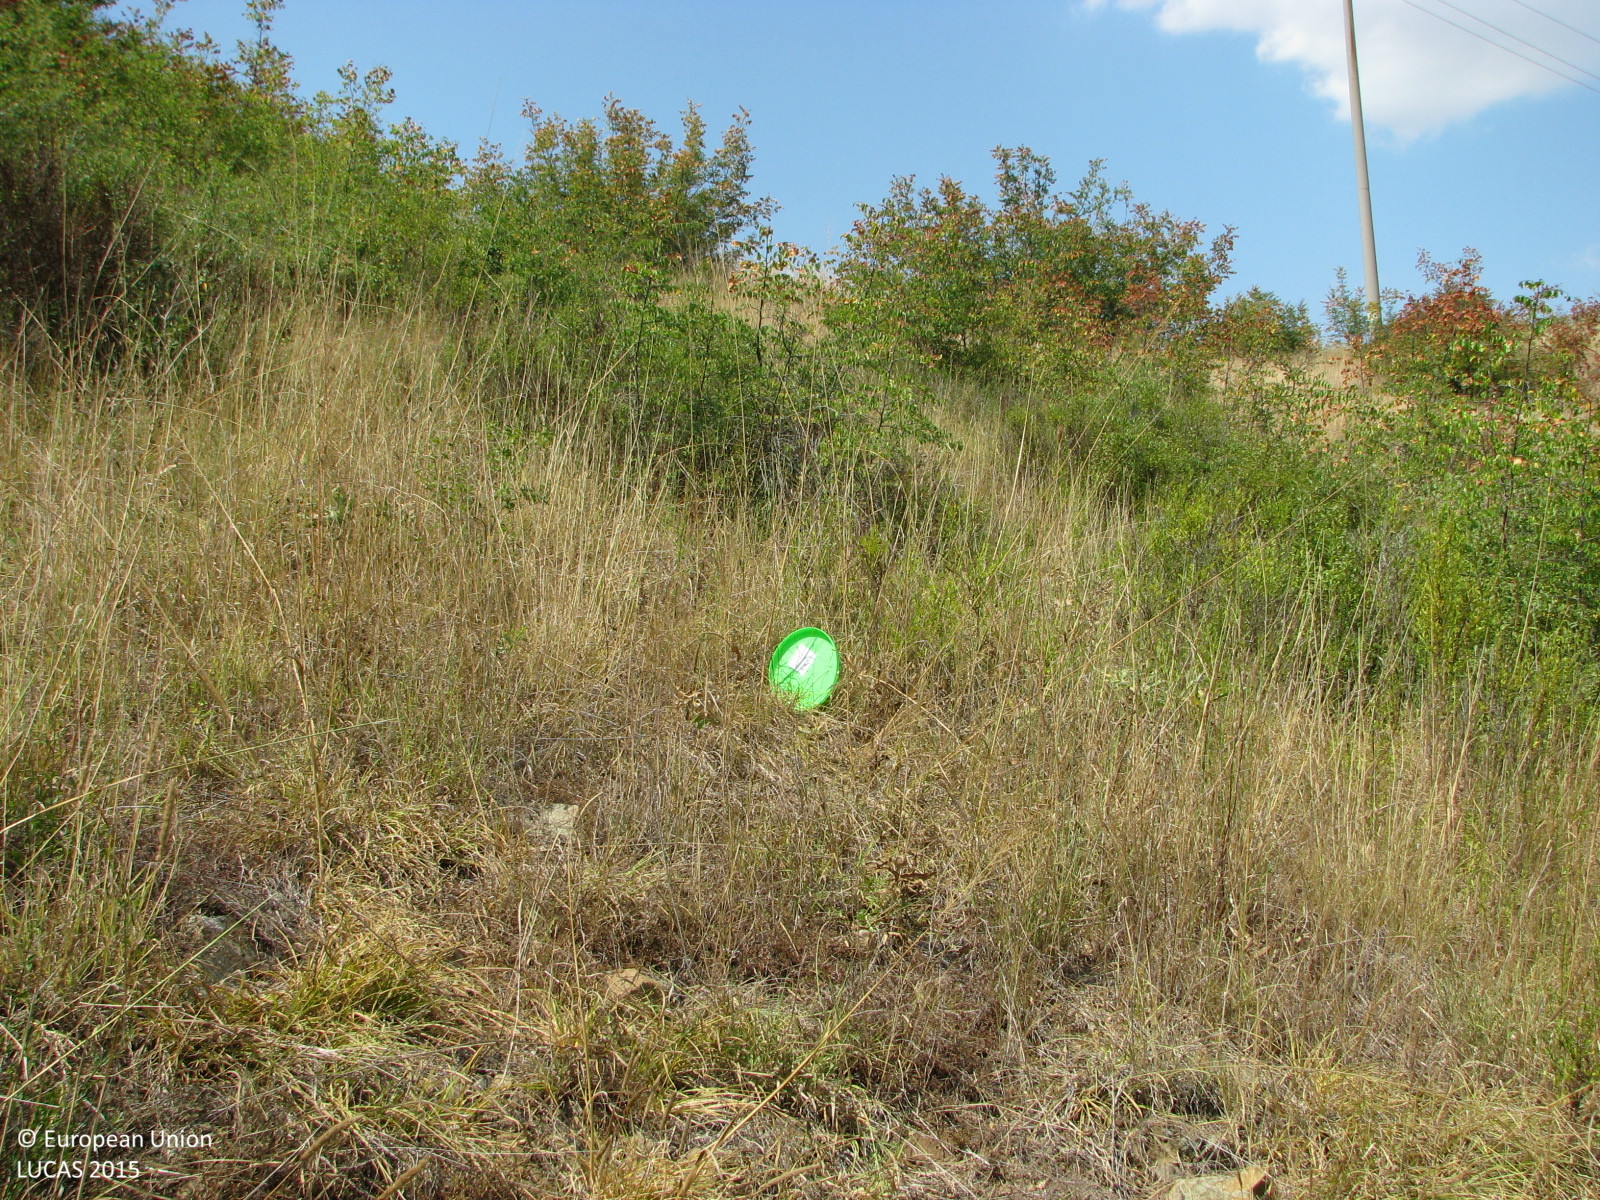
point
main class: Shrubland
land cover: Shrubland with sparse tree cover
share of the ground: 50 - 75 %
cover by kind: shrubs 50 %, herbaceous plants 45 %, broadleaved forest trees 5 %
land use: Agriculture (excluding fallow land and kitchen gardens)
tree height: < 5 m
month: August
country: BG
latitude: 42.1777
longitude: 26.6907
